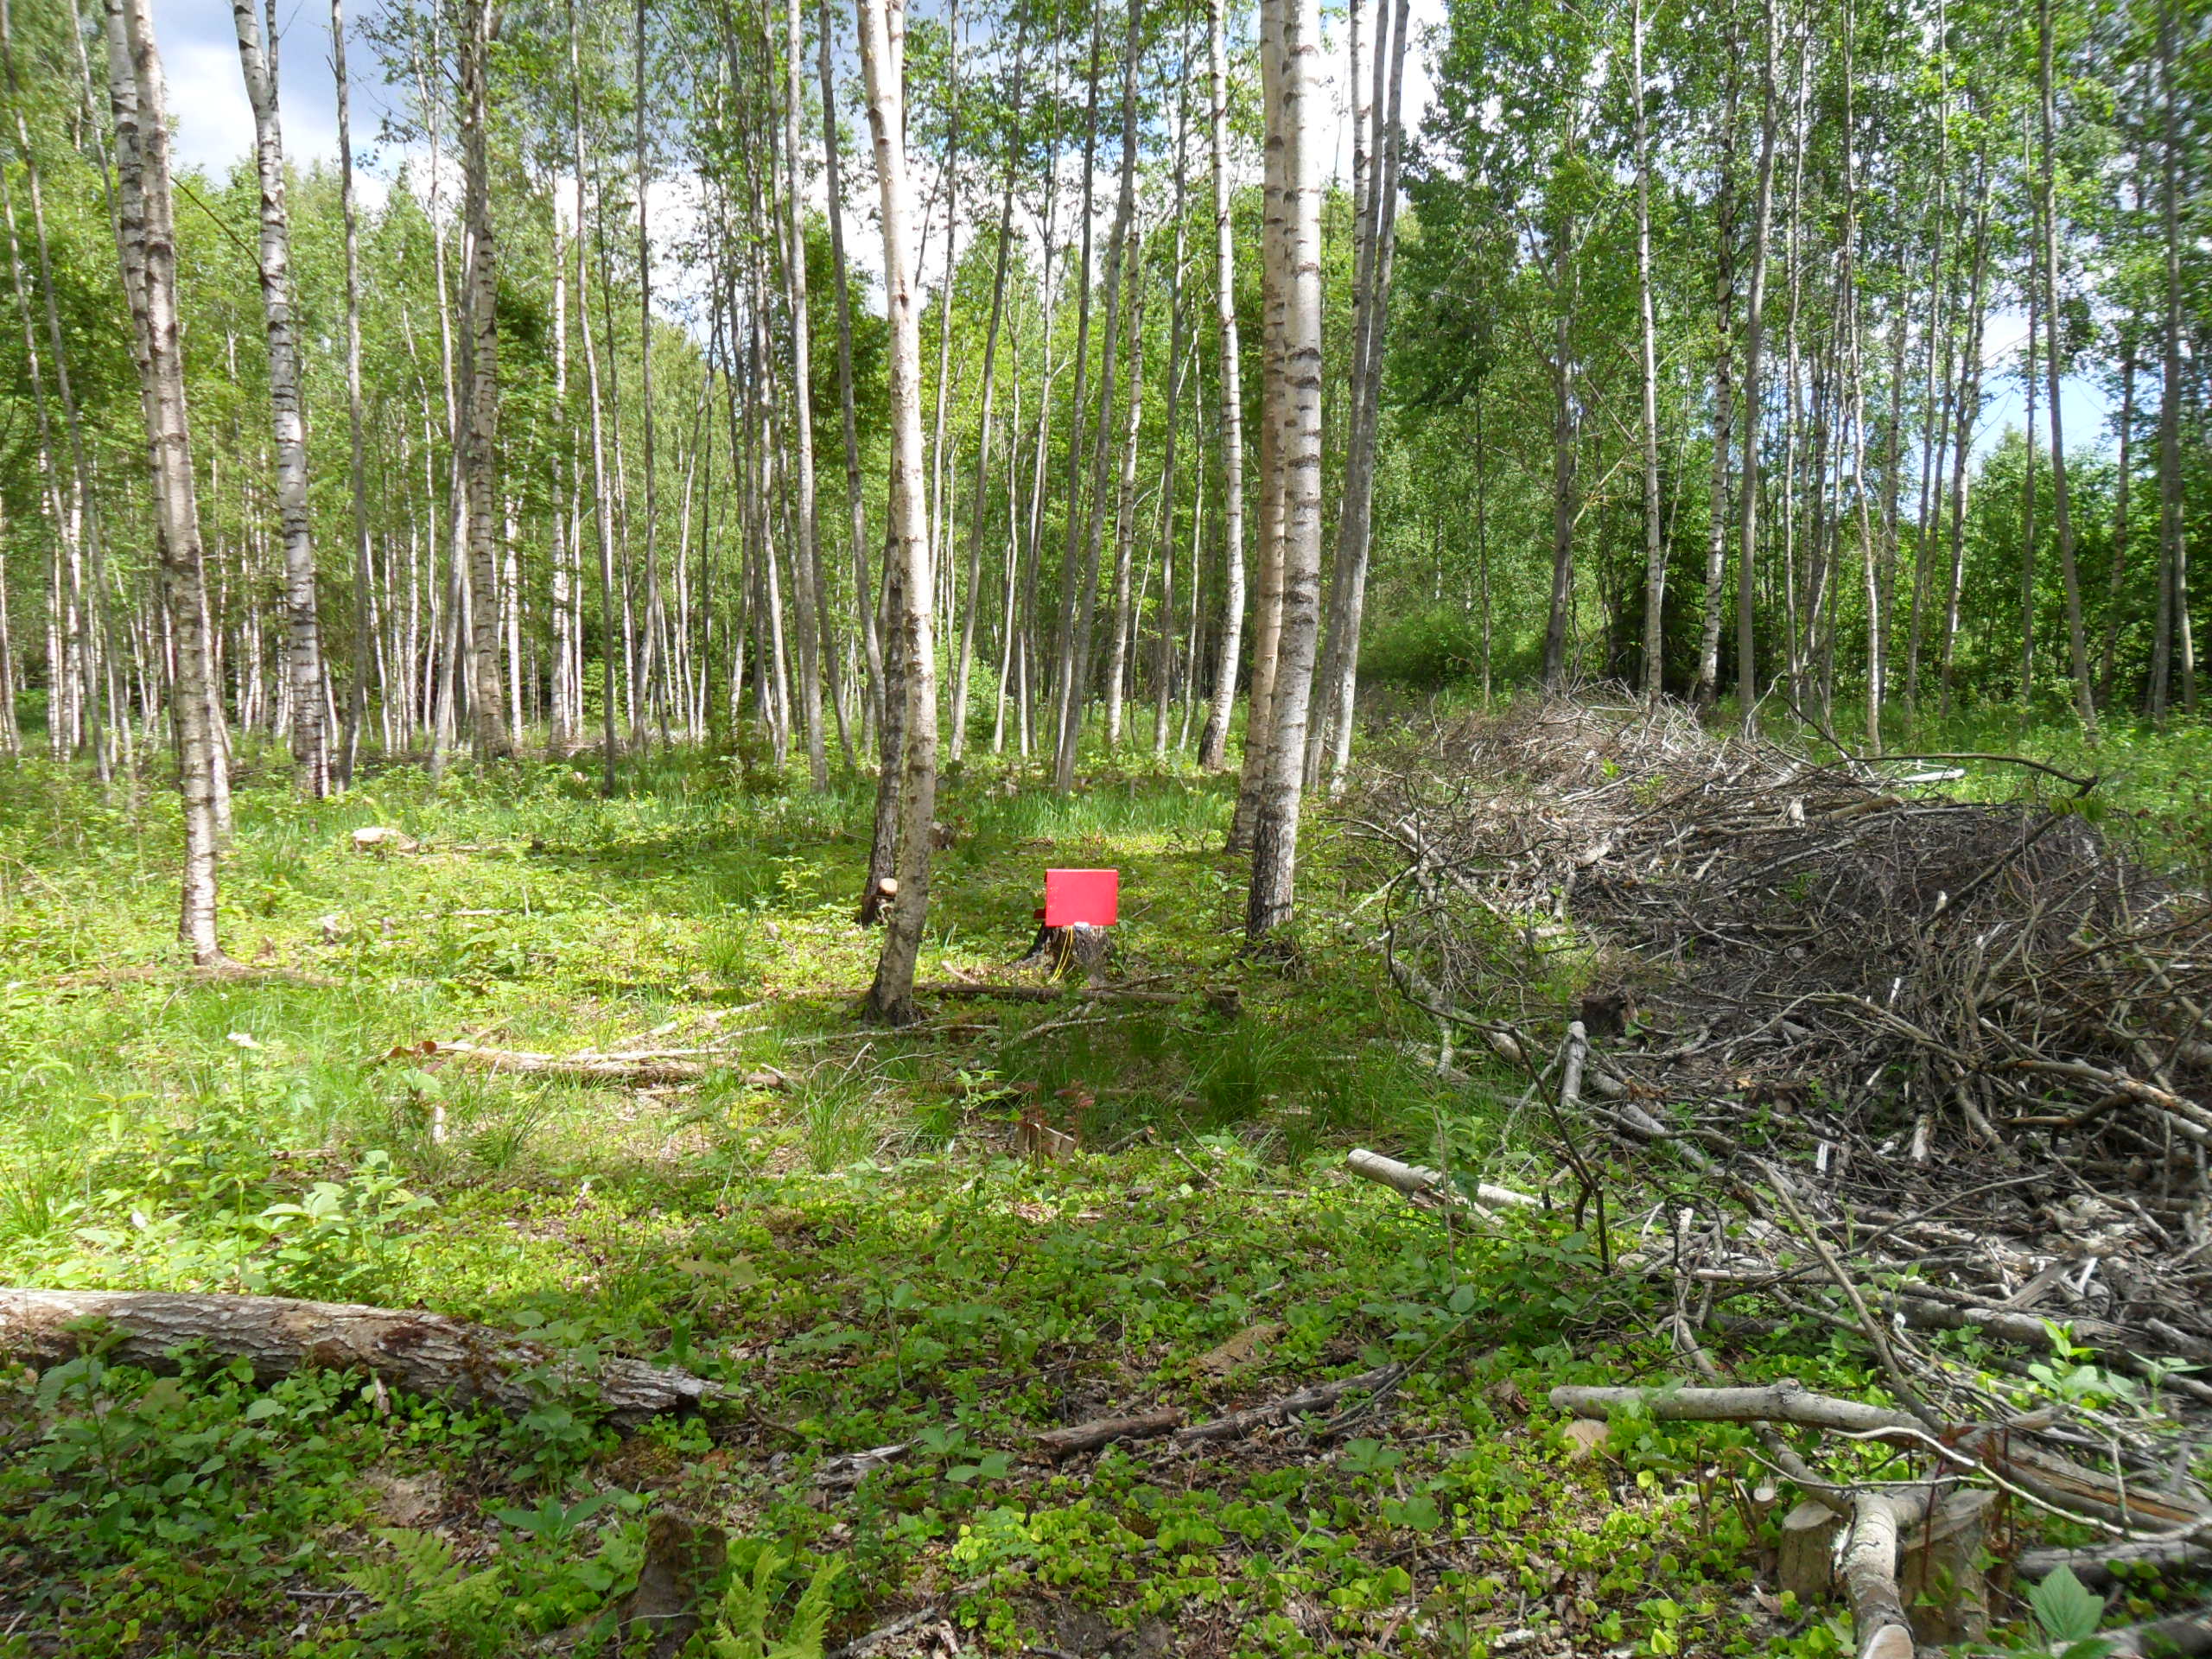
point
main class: Woodland
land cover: Broadleaved woodland
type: non-riverine alder, birch or aspen forest
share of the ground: 50 - 75 %
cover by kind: broadleaved forest trees 60 %, herbaceous plants 20 %, shrubs 10 %, coniferous forest trees 5 %
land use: Forestry
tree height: > 5 m
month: June
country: LV
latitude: 57.5388
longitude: 22.5317
